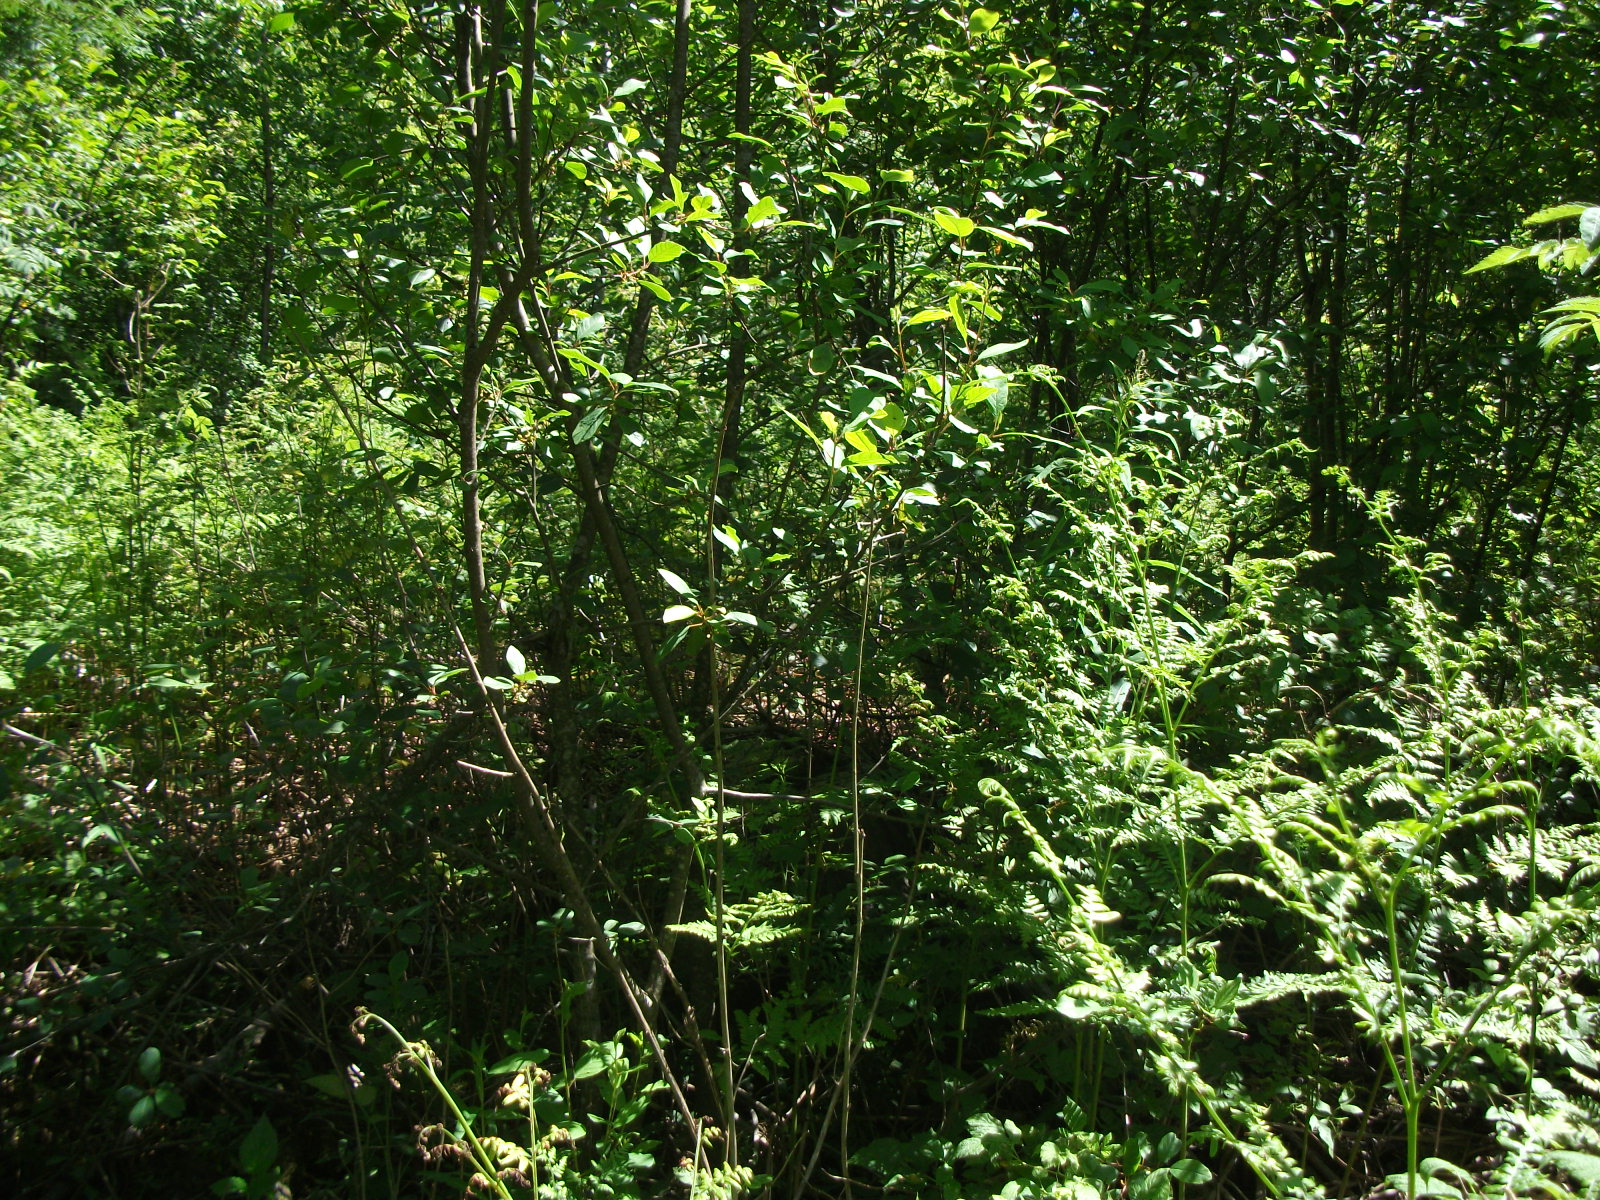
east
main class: Woodland
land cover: Broadleaved woodland
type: non-riverine alder, birch or aspen forest
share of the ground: > 75 %
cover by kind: broadleaved forest trees 90 %, shrubs 5 %, herbaceous plants 5 %
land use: Forestry
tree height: < 5 m
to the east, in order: Broadleaved woodland; Tracks; Spruce dominated coniferous woodland; Spruce dominated mixed woodland
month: July
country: LV
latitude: 56.8028
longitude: 26.2028
